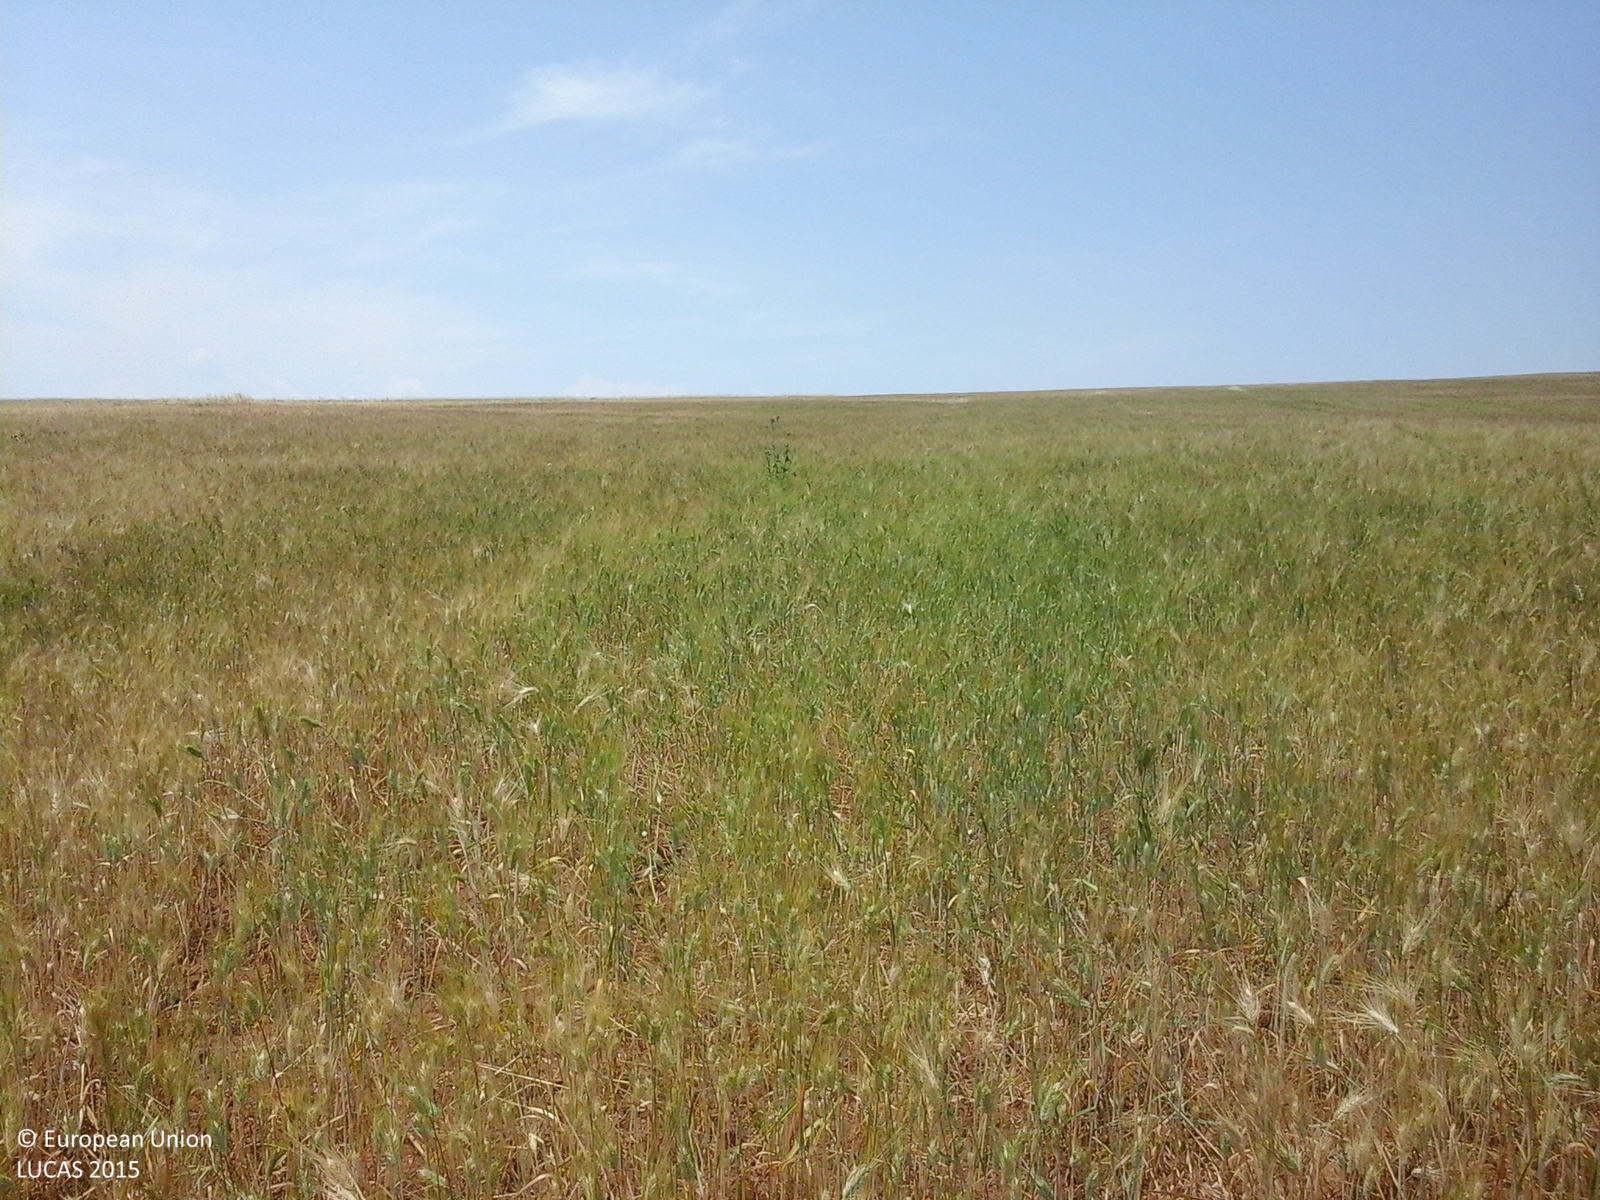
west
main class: Cropland
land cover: Common wheat
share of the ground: > 75 %
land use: Agriculture (excluding fallow land and kitchen gardens)
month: June
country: GR
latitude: 40.4555
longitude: 22.8931
